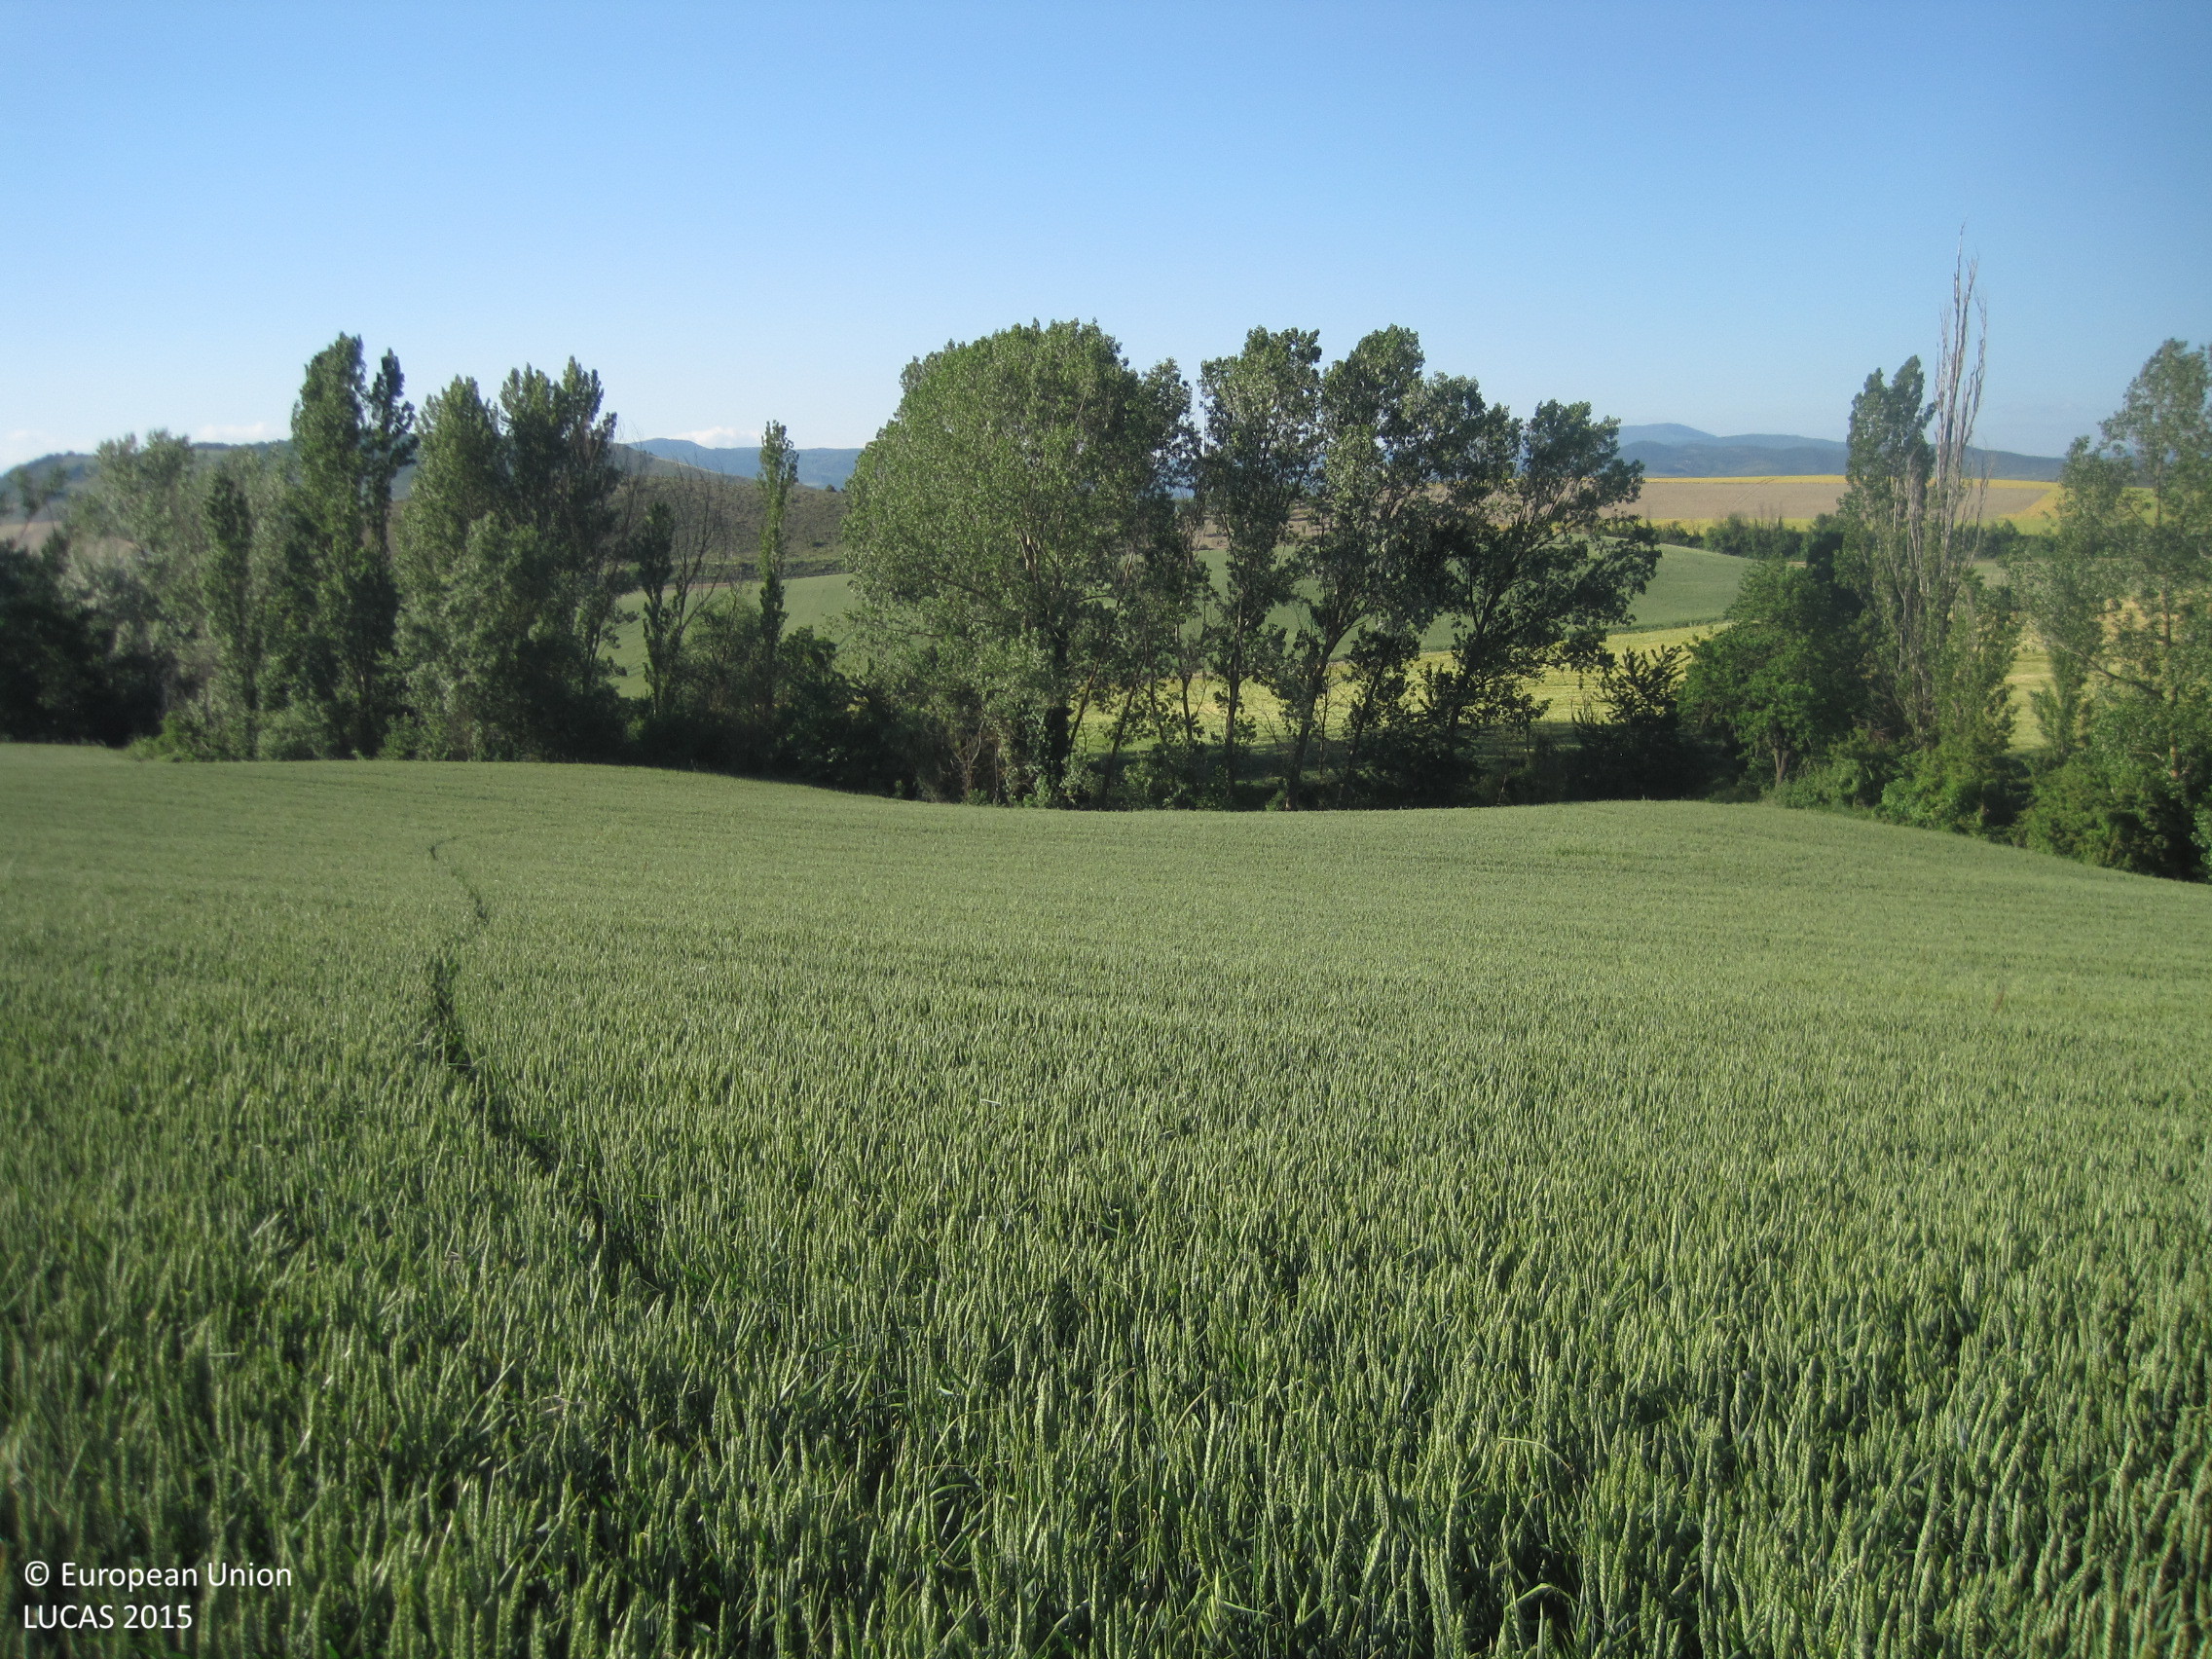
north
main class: Cropland
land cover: Common wheat
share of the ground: > 75 %
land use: Agriculture (excluding fallow land and kitchen gardens)
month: May
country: ES
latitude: 42.7484
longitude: -1.4595
